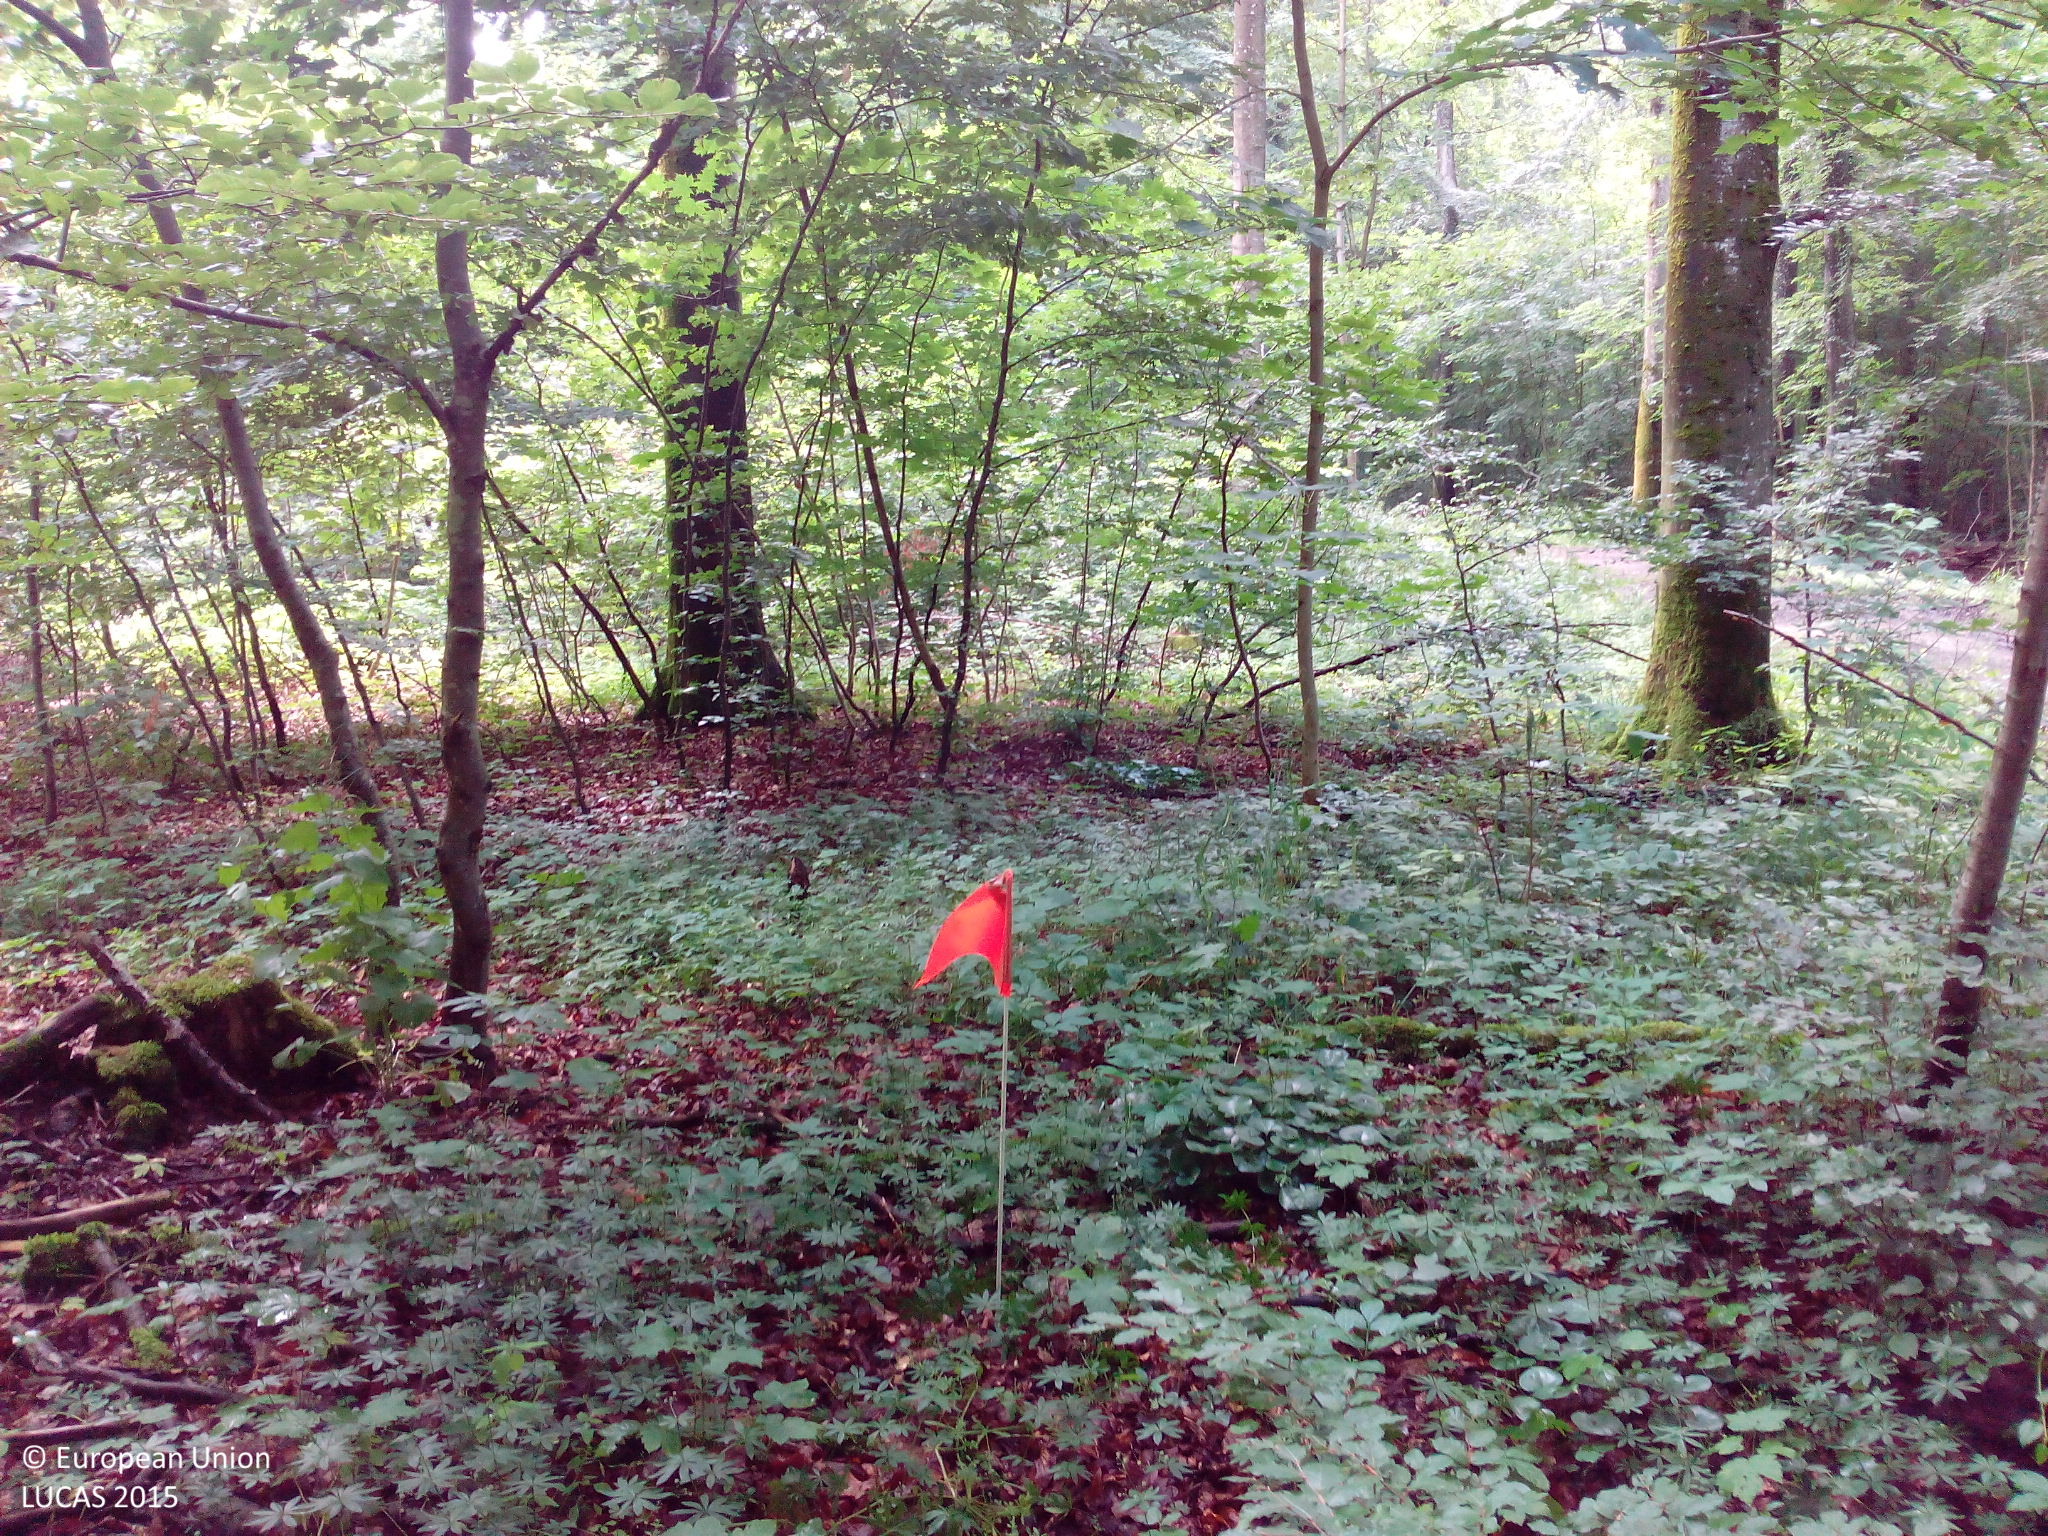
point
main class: Woodland
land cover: Broadleaved woodland
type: mesophytic deciduous forest
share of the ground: > 75 %
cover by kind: broadleaved forest trees 90 %, shrubs 5 %, herbaceous plants 5 %
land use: Forestry
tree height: > 5 m
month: June
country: DE
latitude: 48.5459
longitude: 9.4178
